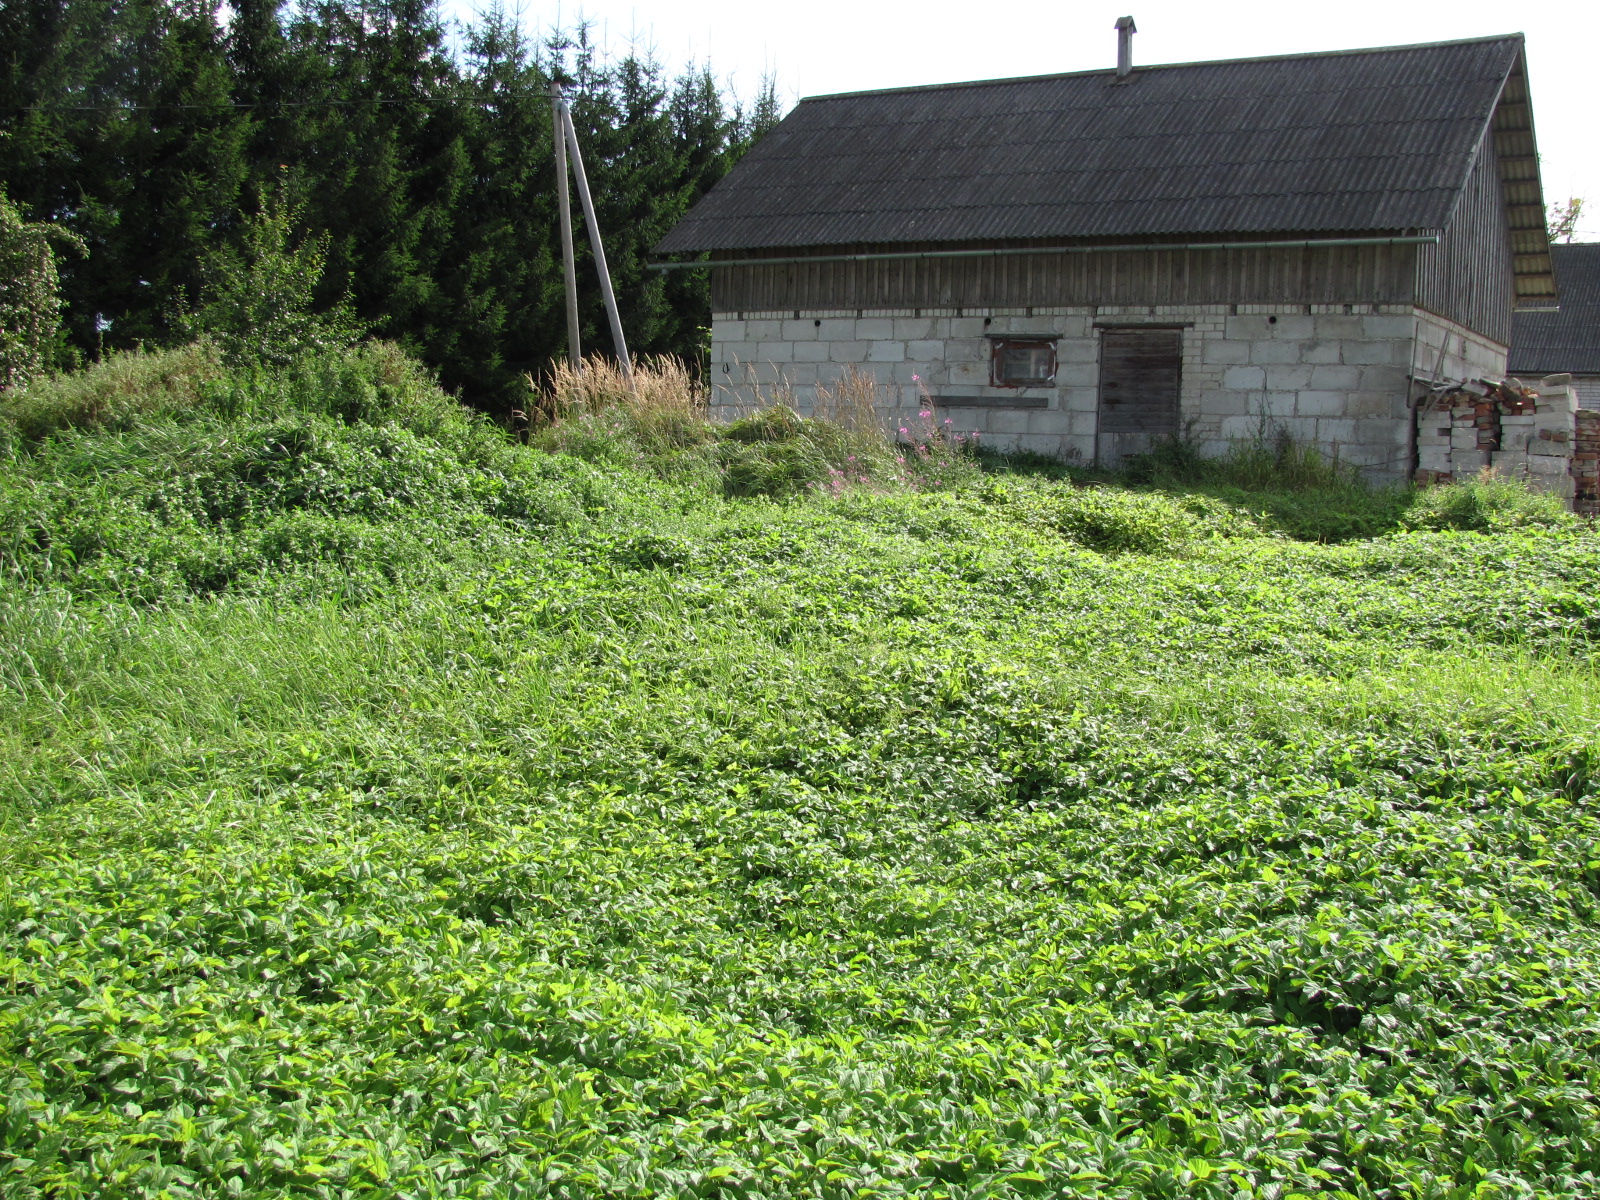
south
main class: Grassland
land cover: Grassland without tree/shrub cover
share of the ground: > 75 %
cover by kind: herbaceous plants 100 %
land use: Agriculture (excluding fallow land and kitchen gardens)
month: August
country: LV
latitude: 56.8891
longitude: 25.1949
